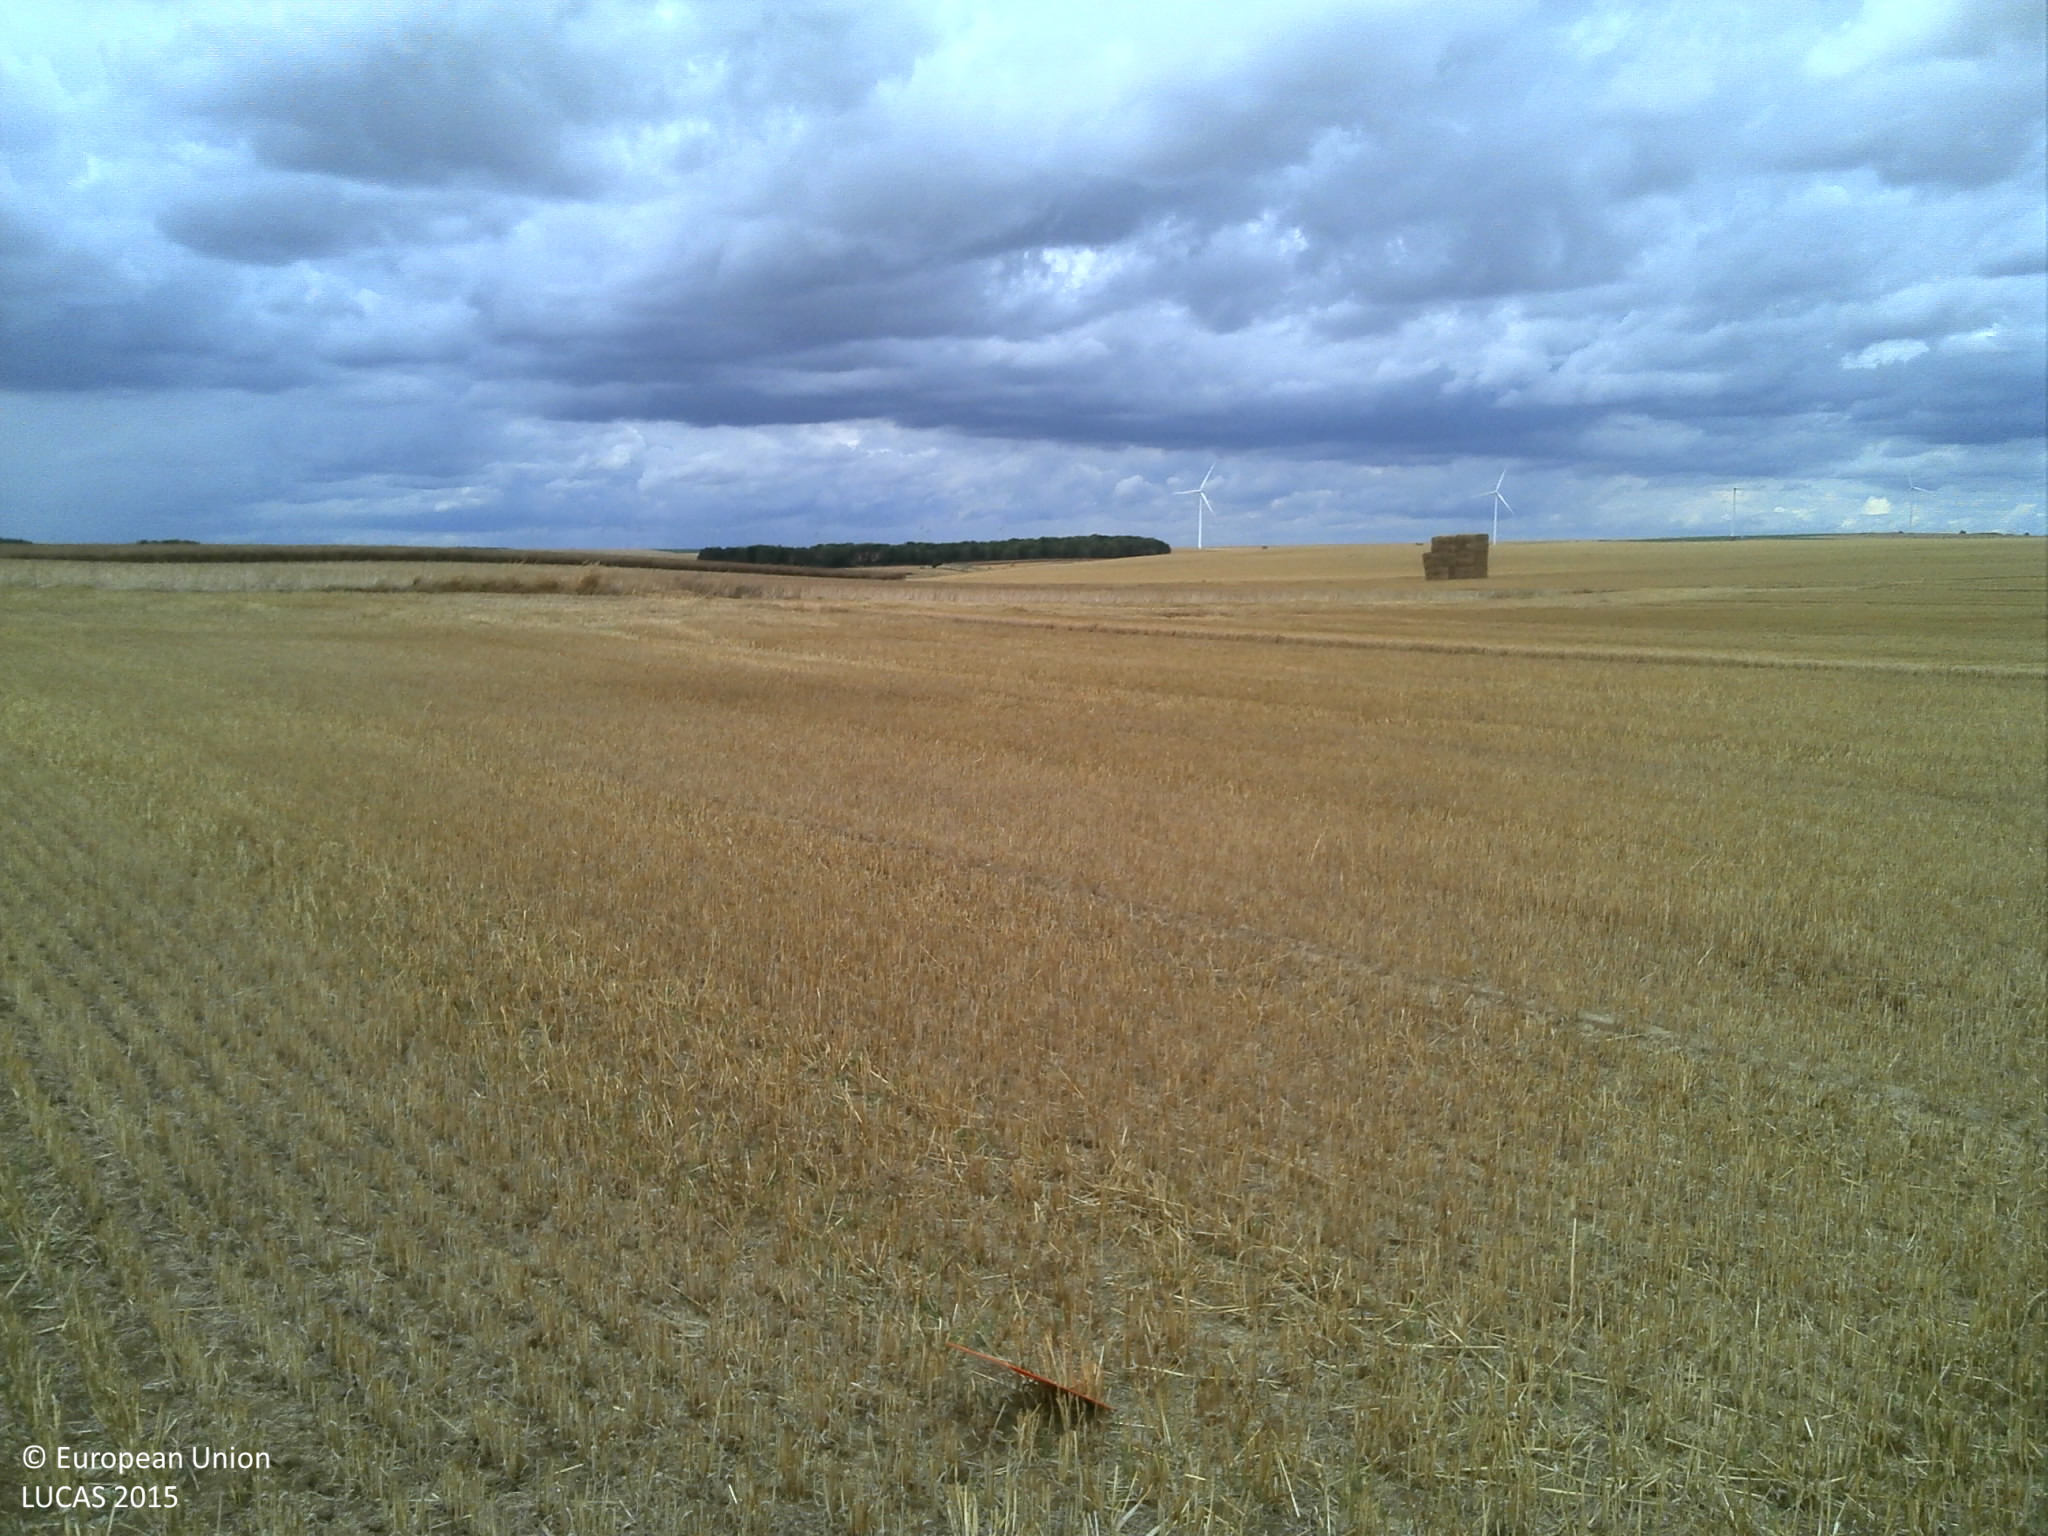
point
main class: Cropland
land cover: Barley
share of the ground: 50 - 75 %
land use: Agriculture (excluding fallow land and kitchen gardens)
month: July
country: FR
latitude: 49.3501
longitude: 4.5314
